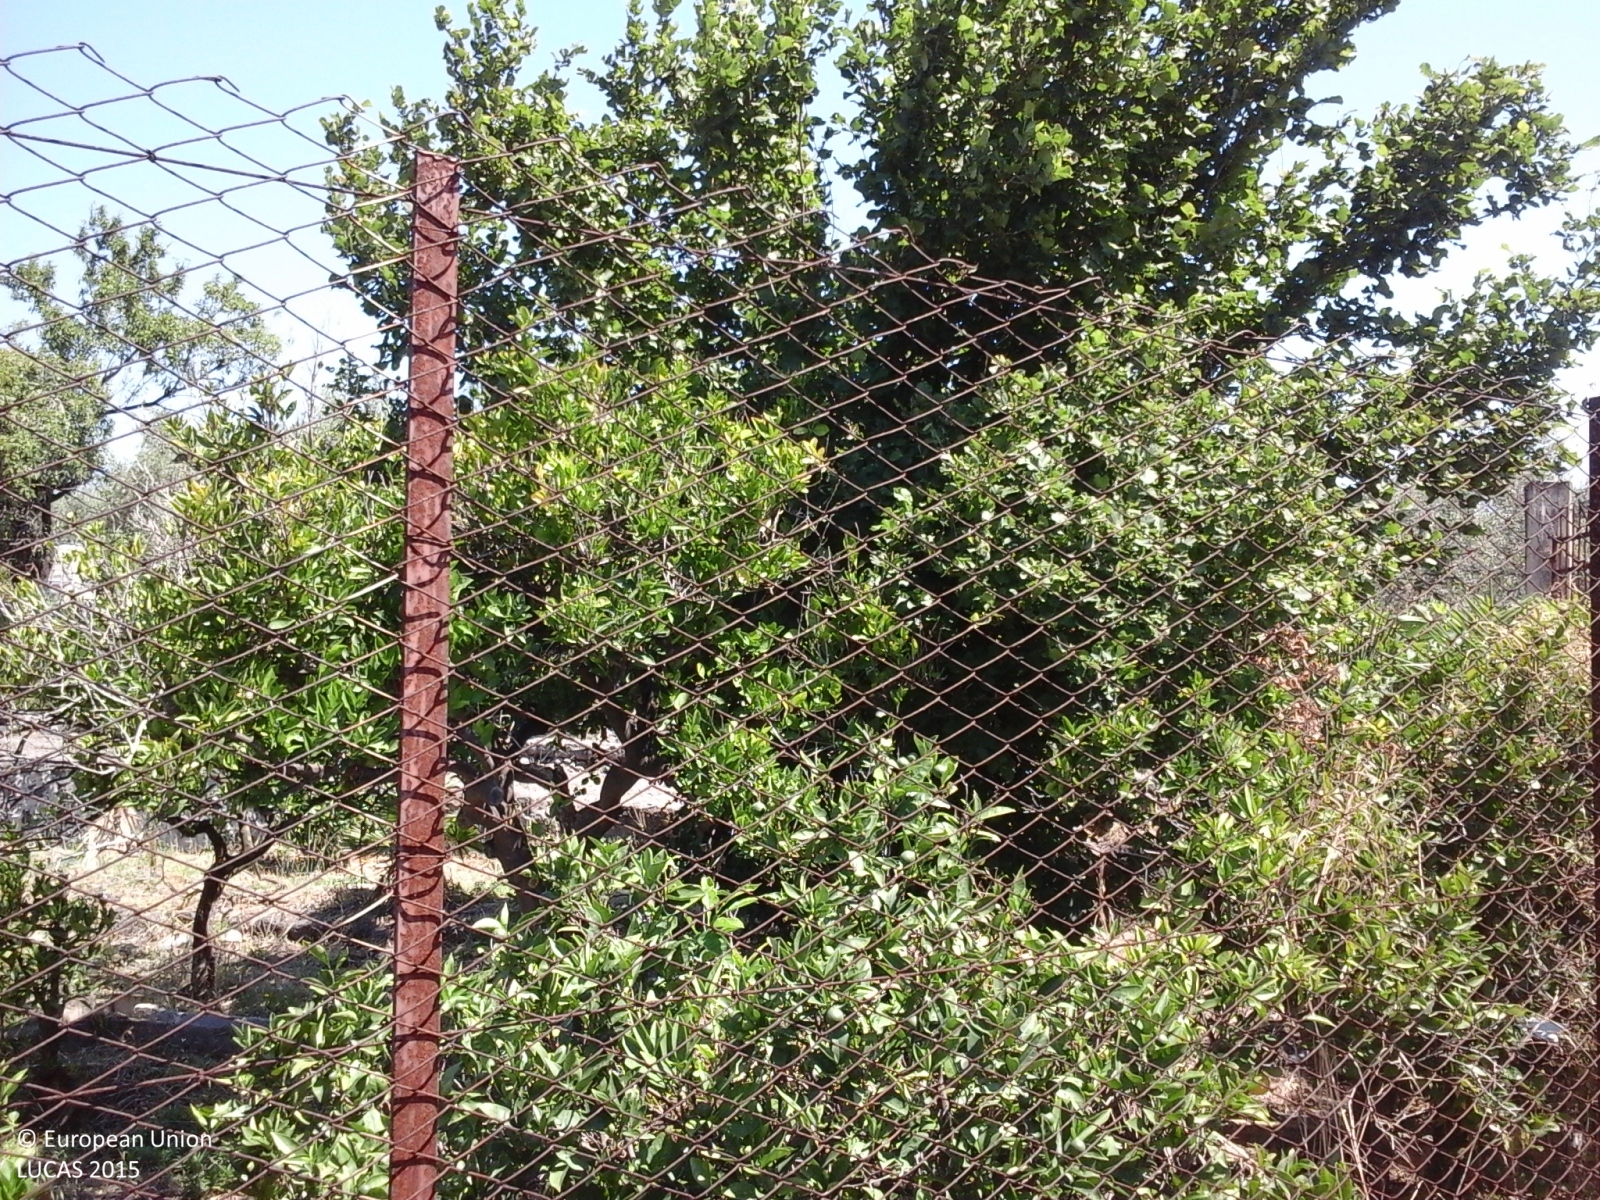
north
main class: Cropland
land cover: Other fruit trees and berries
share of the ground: 25 - 50 %
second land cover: Olive groves
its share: > 75 %
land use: Agriculture (excluding fallow land and kitchen gardens)
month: June
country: IT
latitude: 37.6046
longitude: 14.8700
